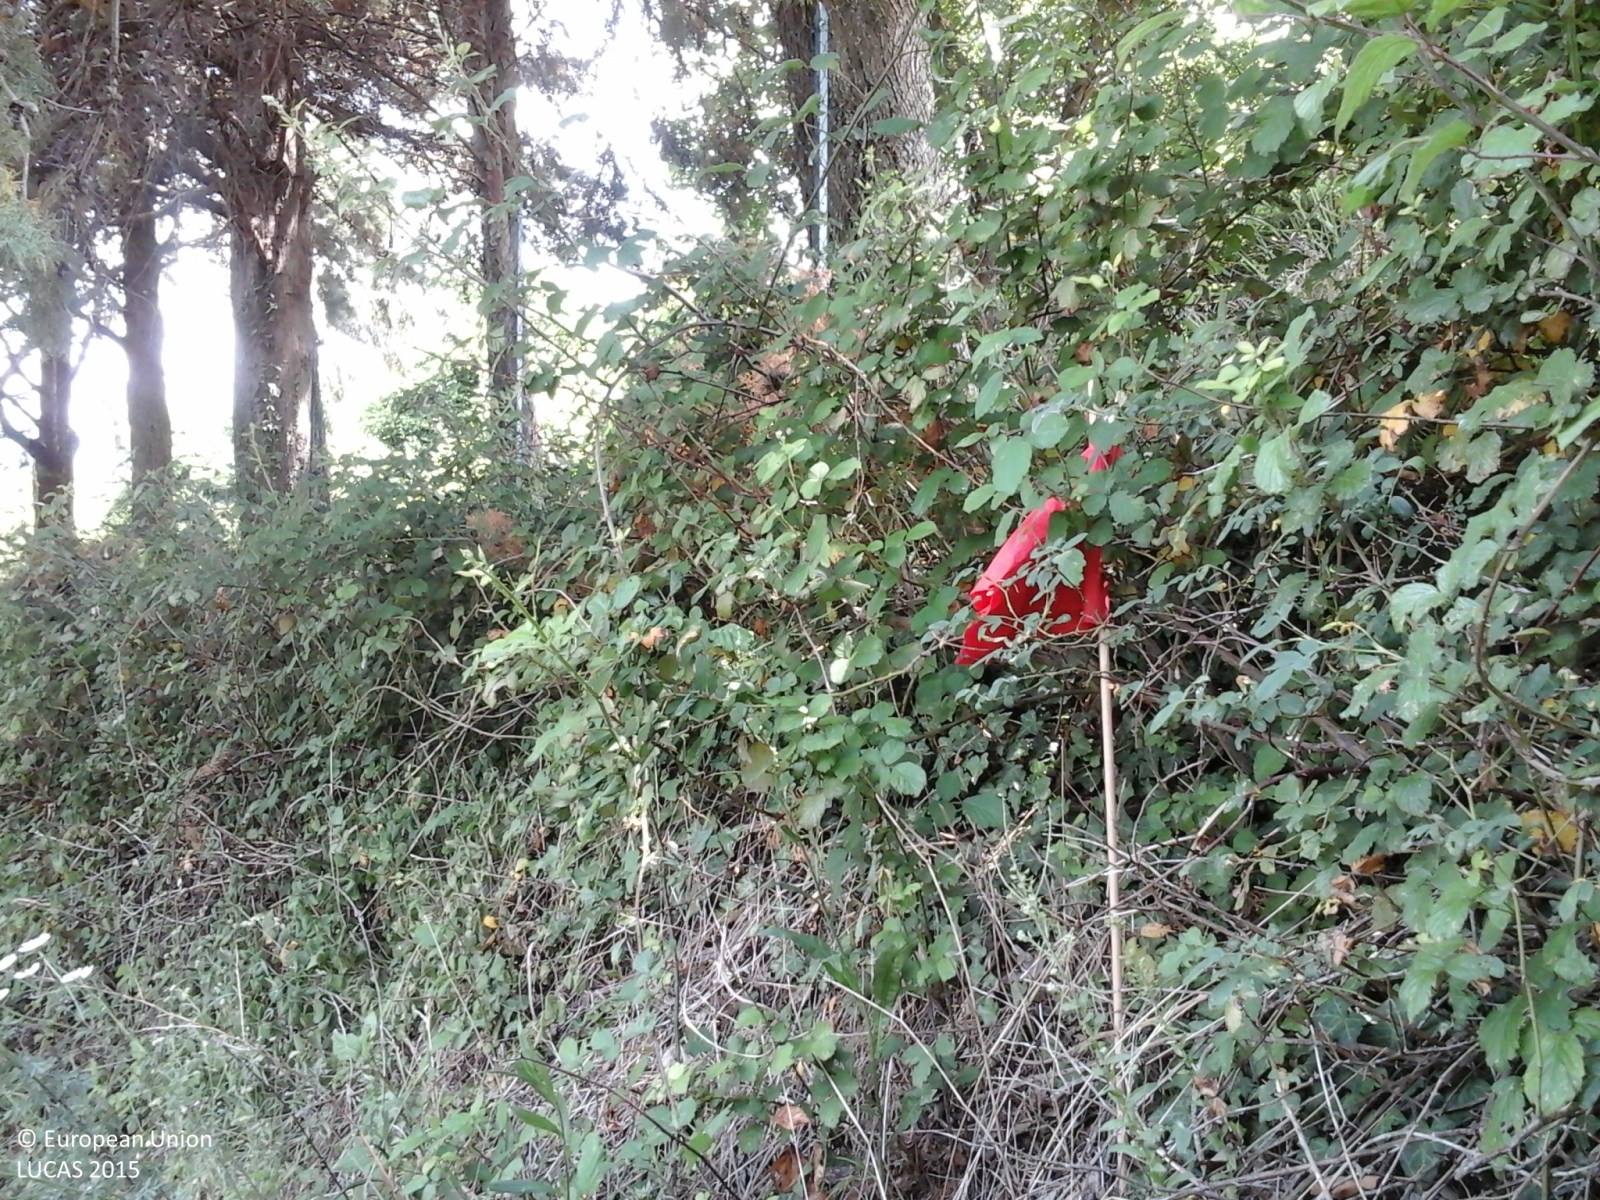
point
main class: Shrubland
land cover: Shrubland with sparse tree cover
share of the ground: > 75 %
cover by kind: shrubs 85 %, herbaceous plants 10 %, broadleaved forest trees 5 %
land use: Semi-natural and natural areas not in use
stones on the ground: < 10 %
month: June
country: IT
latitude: 43.8334
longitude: 11.5754
